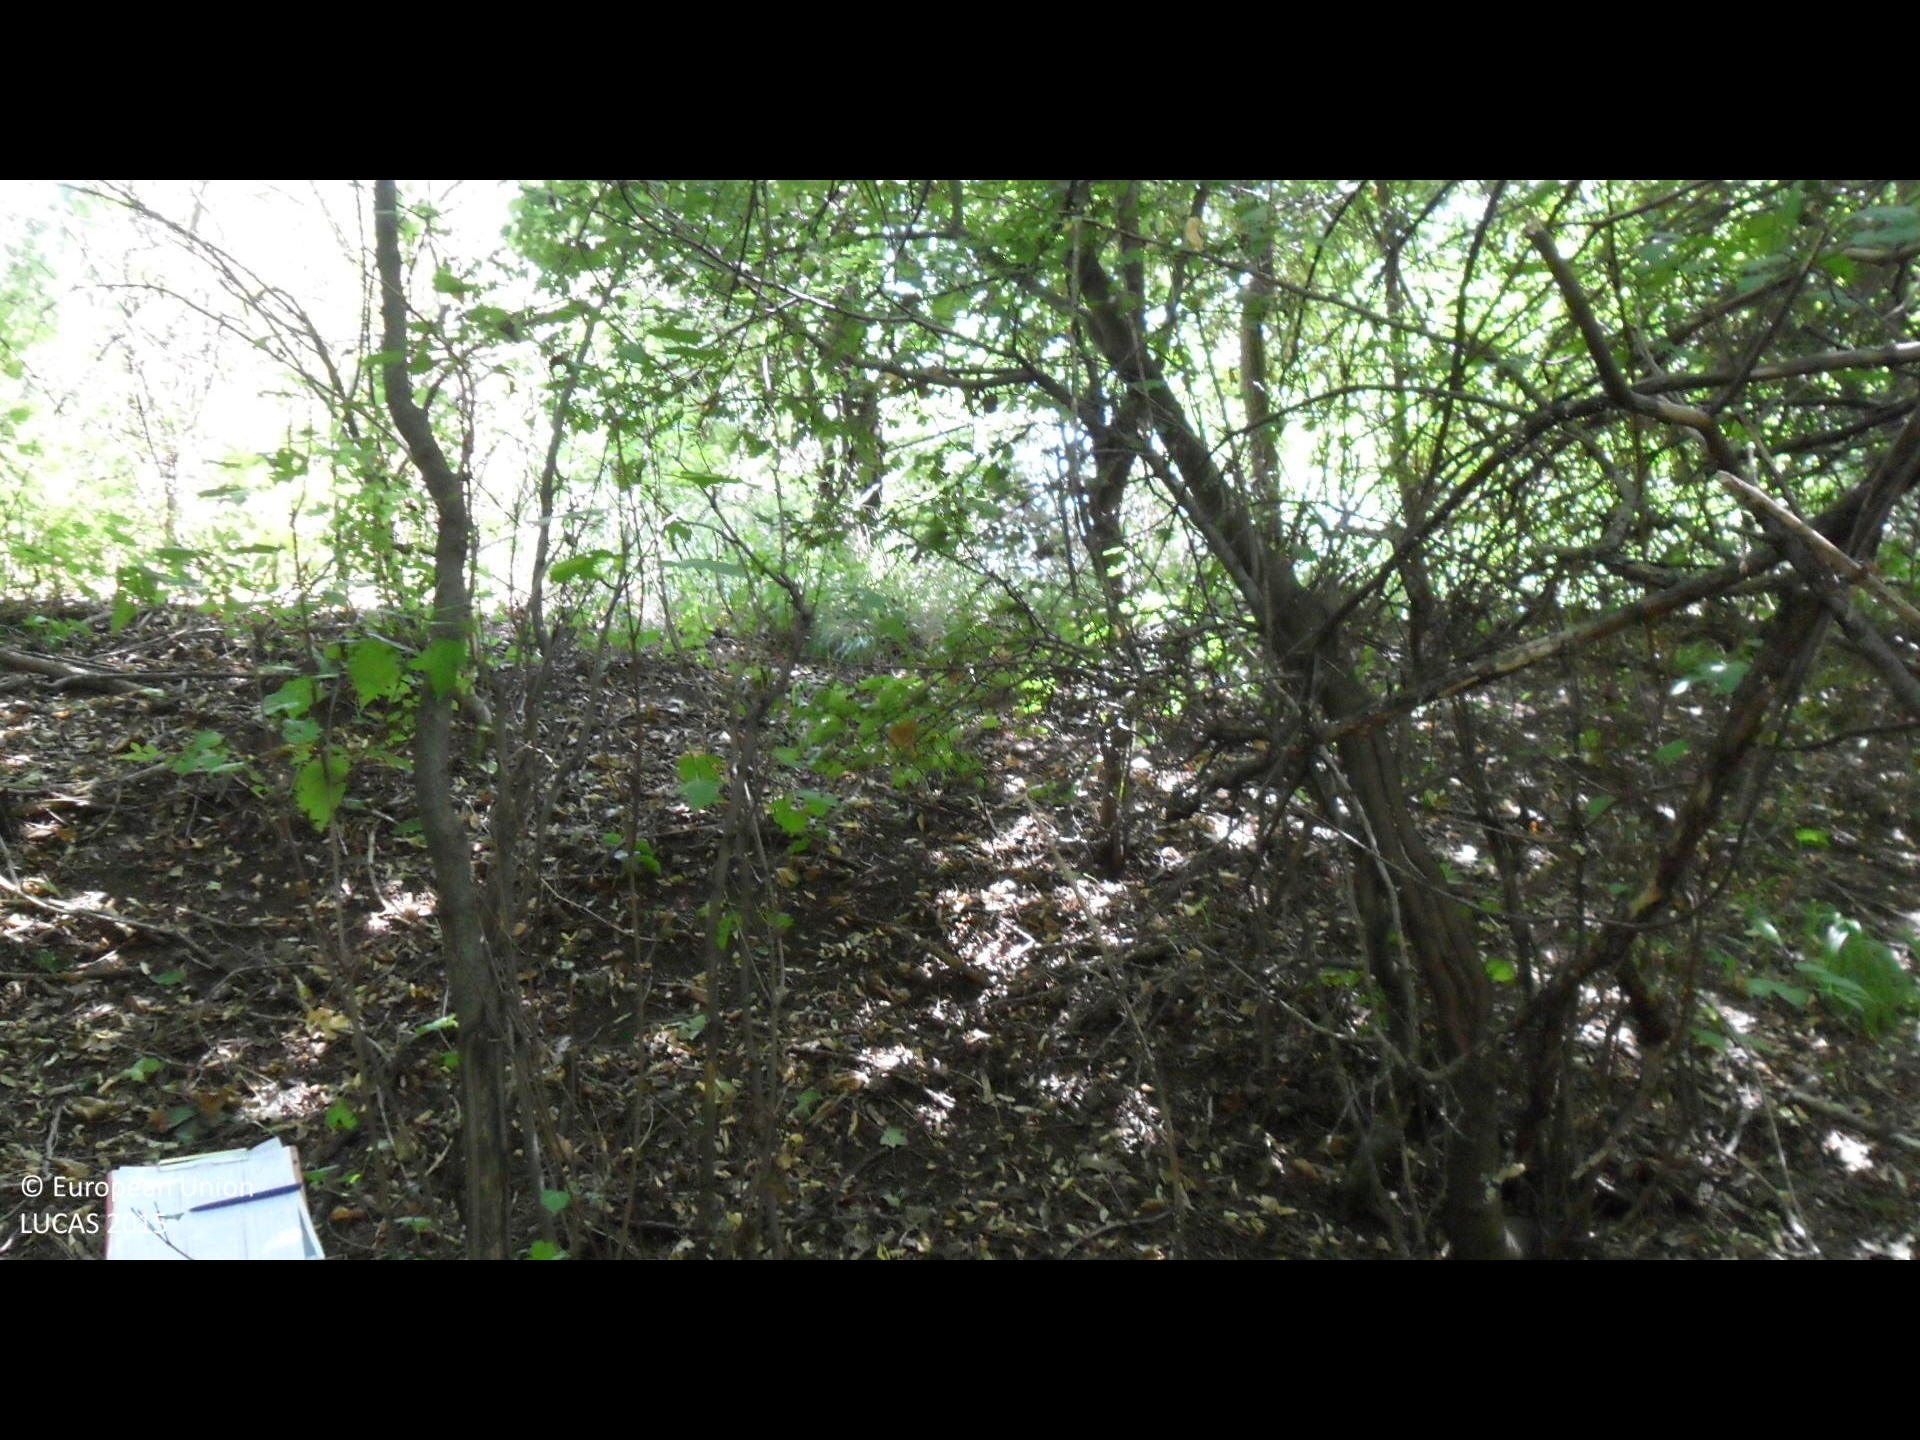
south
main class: Woodland
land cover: Broadleaved woodland
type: mesophytic deciduous forest
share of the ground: > 75 %
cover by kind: broadleaved forest trees 90 %, shrubs 10 %
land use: Forestry
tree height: > 5 m
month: August
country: BG
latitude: 43.3126
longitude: 26.1595
